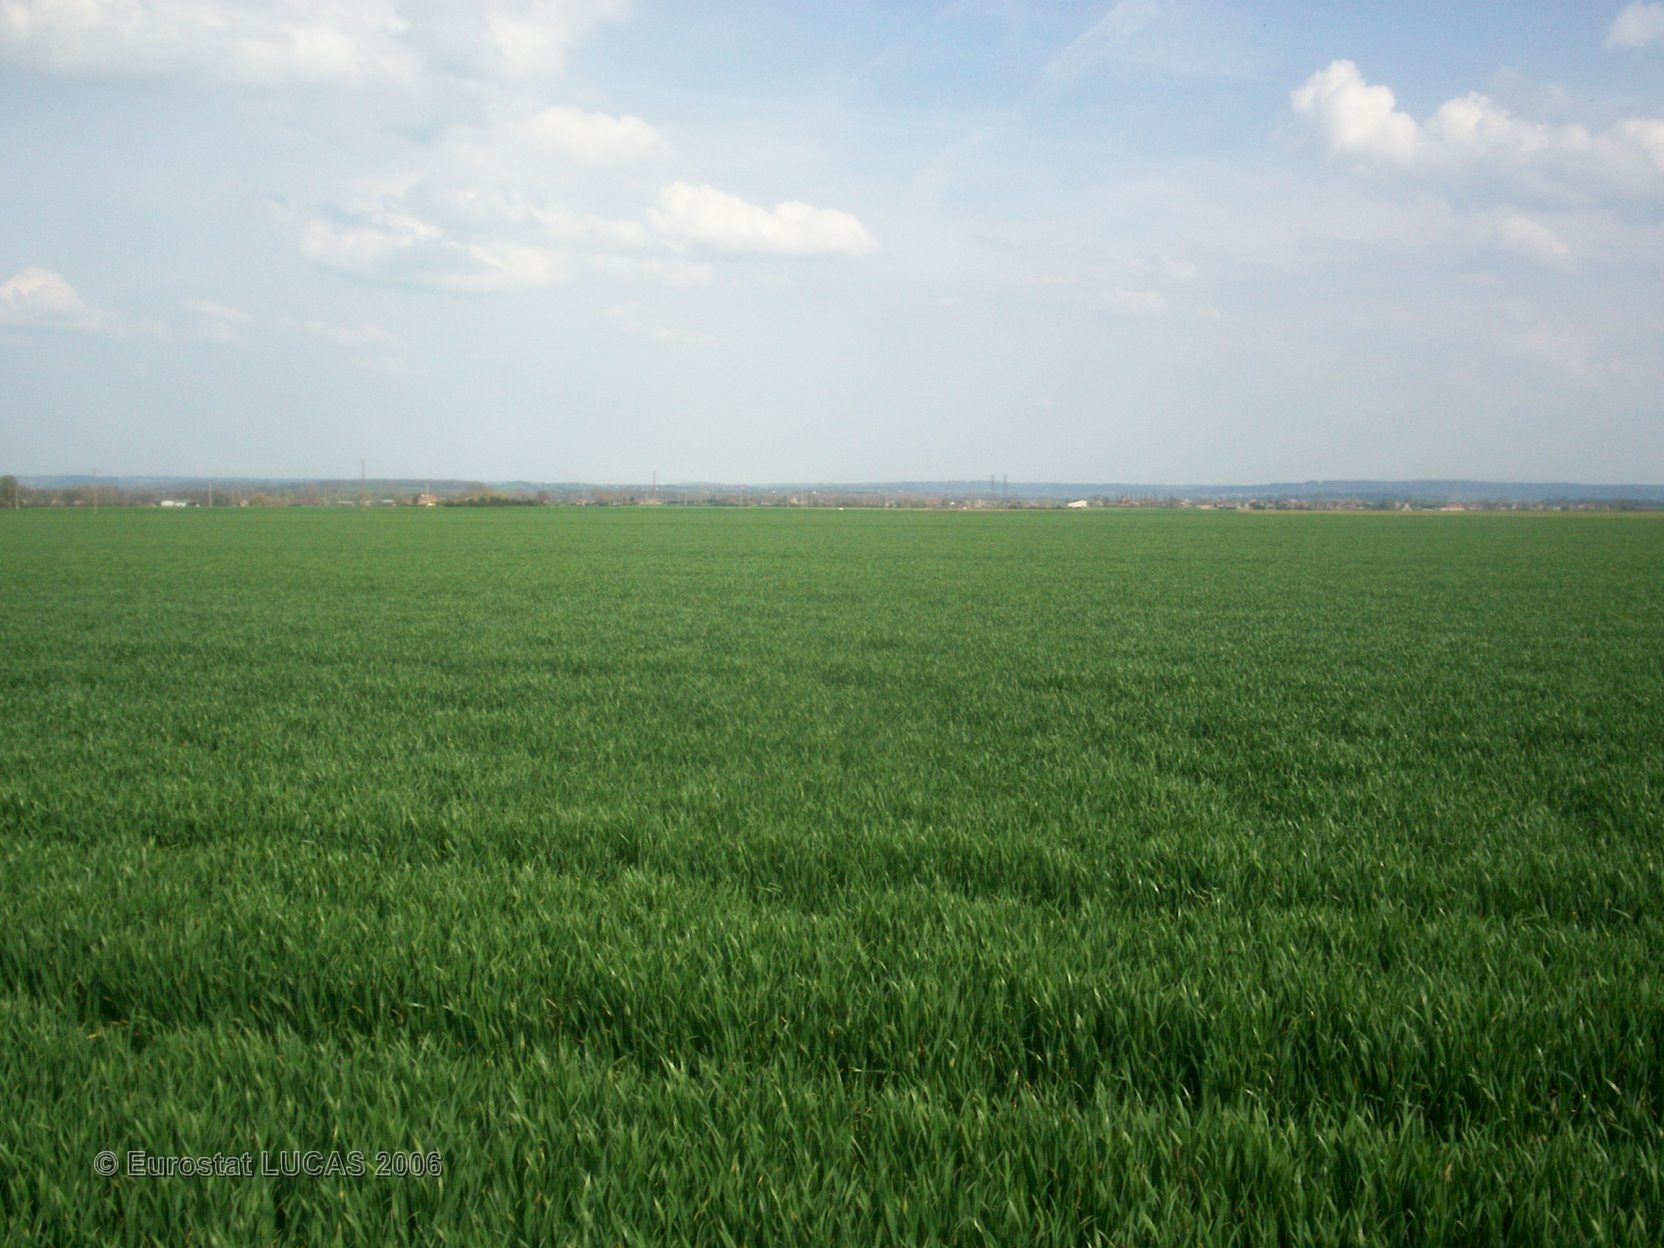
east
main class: Cropland
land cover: Common wheat
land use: Agriculture (excluding fallow land and kitchen gardens)
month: April
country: FR
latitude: 49.0647
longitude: -0.0914
